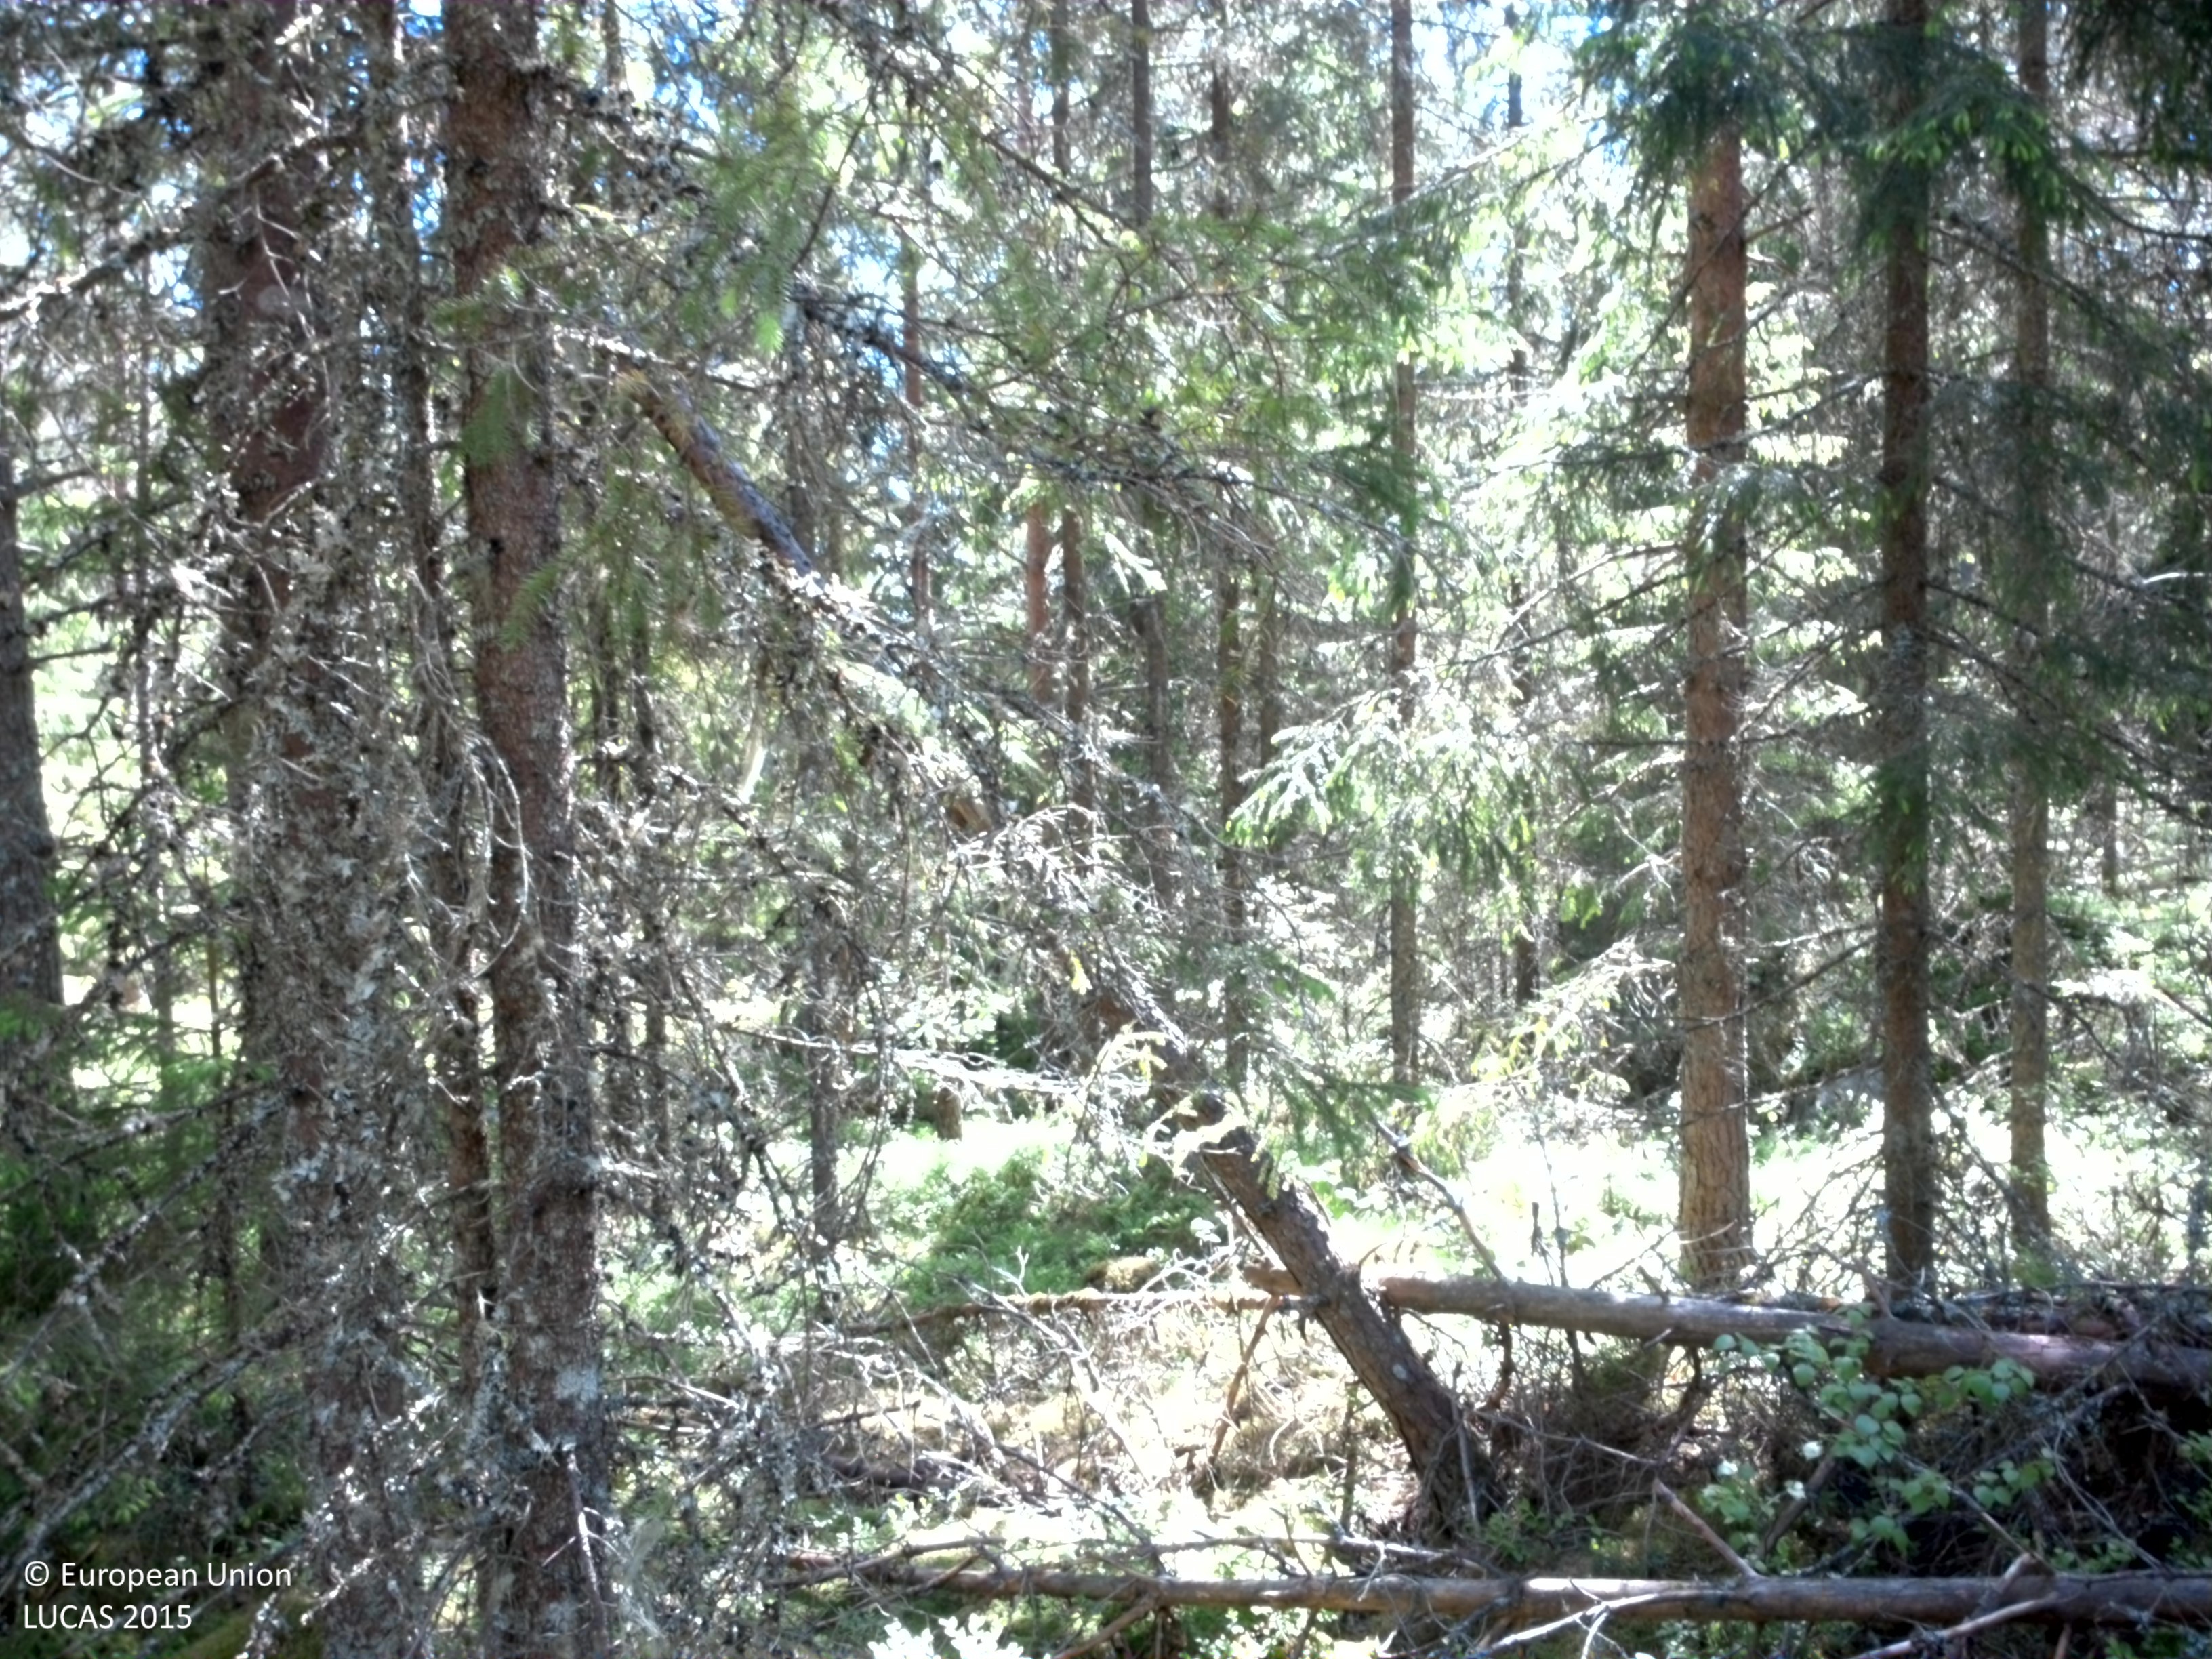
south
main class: Woodland
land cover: Pine dominated coniferous woodland
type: boreal forest
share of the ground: > 75 %
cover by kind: coniferous forest trees 75 %, shrubs 15 %, broadleaved forest trees 5 %, herbaceous plants 5 %
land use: Forestry
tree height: > 5 m
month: June
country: SE
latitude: 59.5893
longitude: 12.0667
